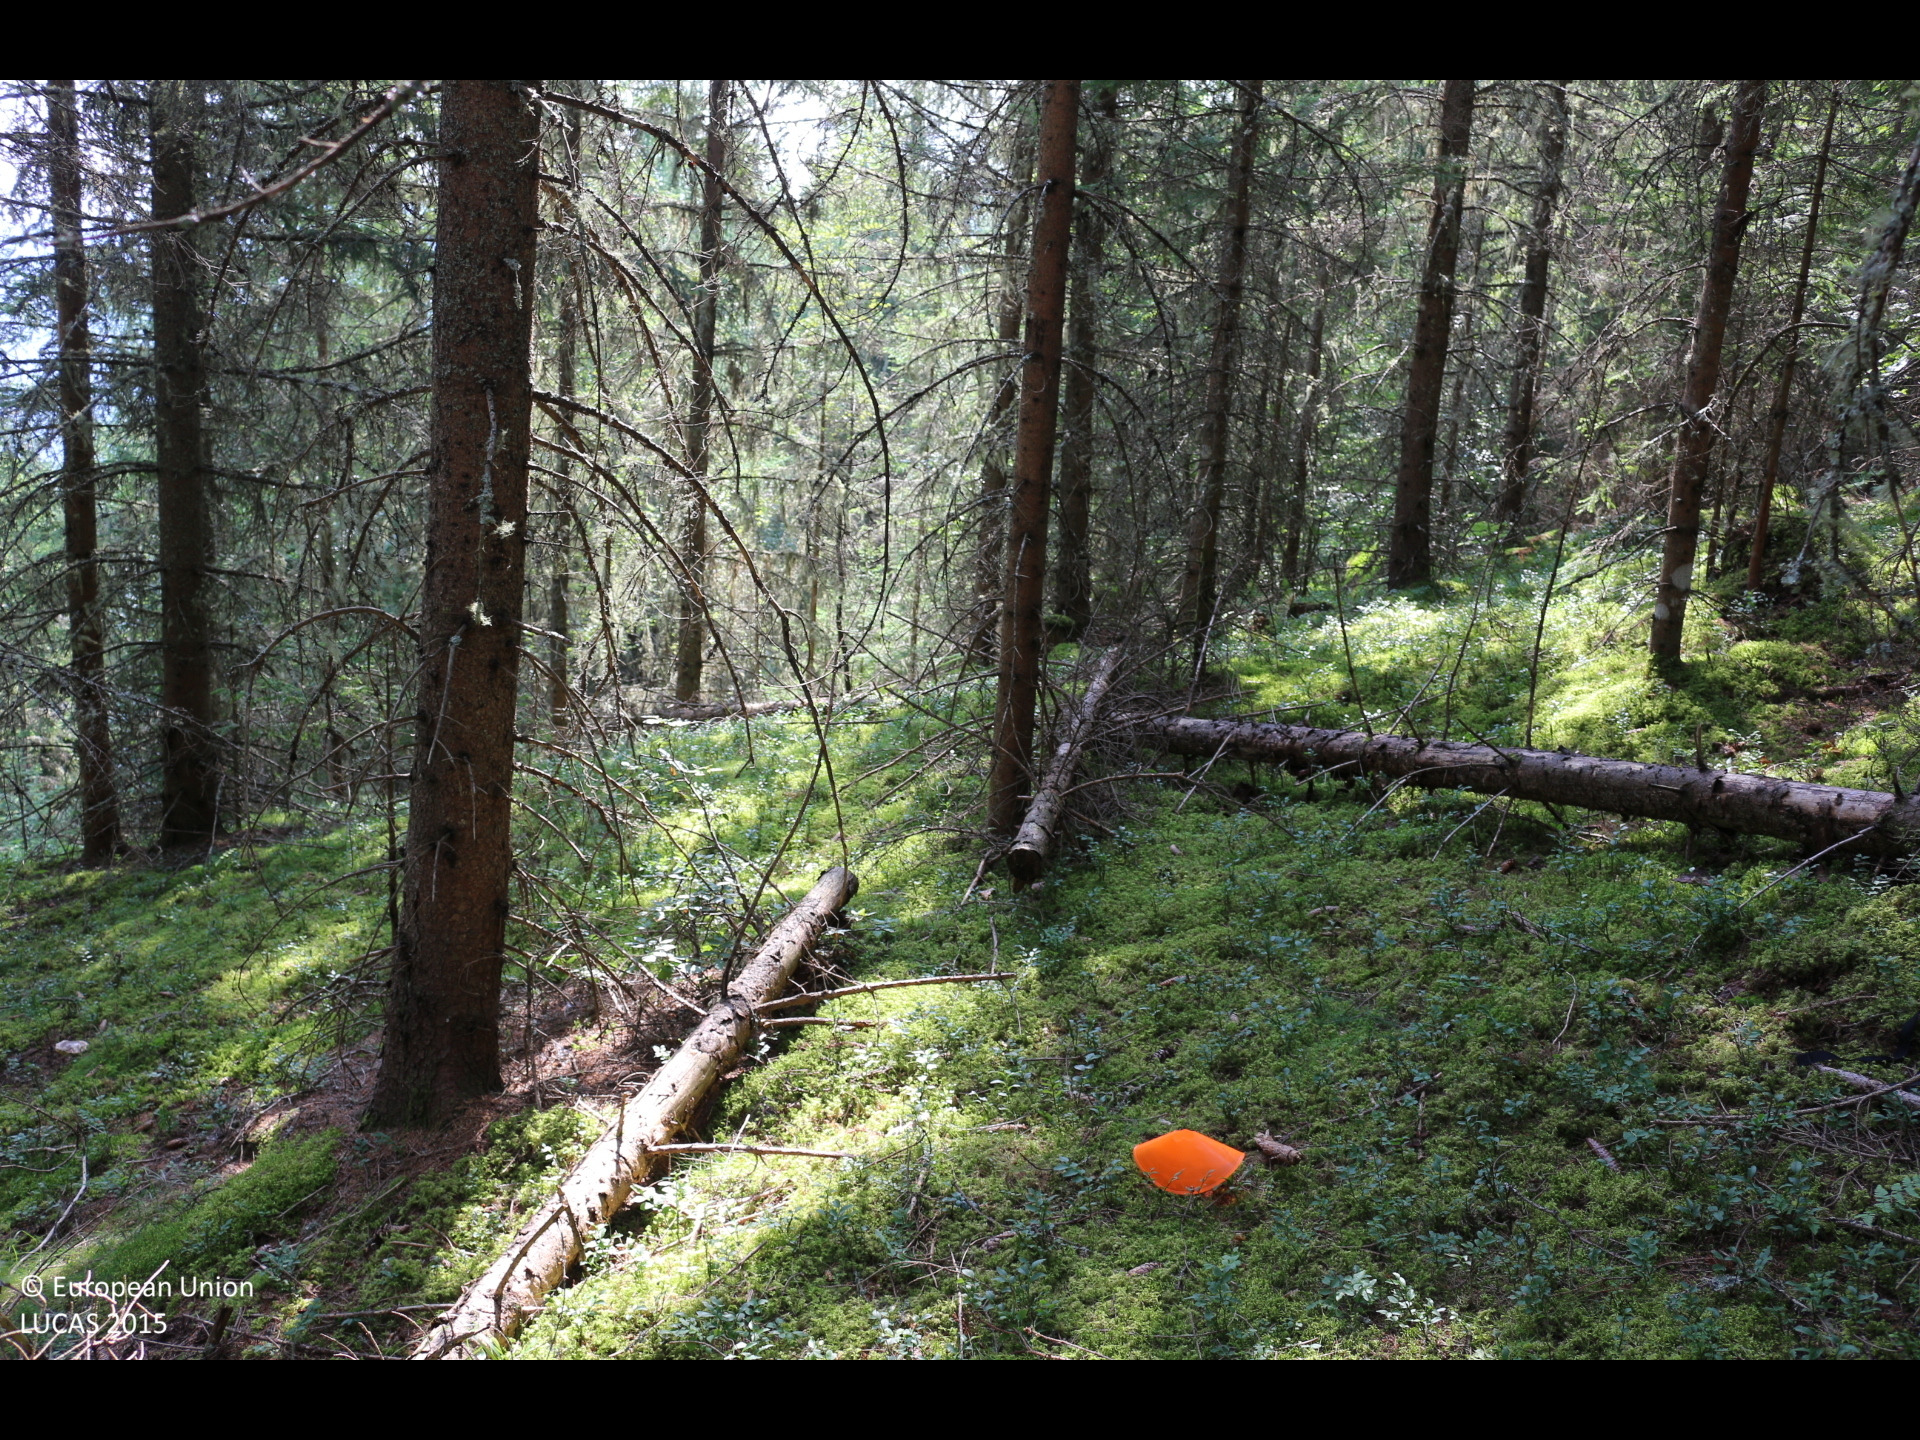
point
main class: Woodland
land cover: Spruce dominated coniferous woodland
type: alpine coniferous forest
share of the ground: > 75 %
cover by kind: coniferous forest trees 90 %, lichens and mosses 10 %
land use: Forestry
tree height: > 5 m
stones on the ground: < 10 %
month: August
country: AT
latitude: 46.9744
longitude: 14.1386
